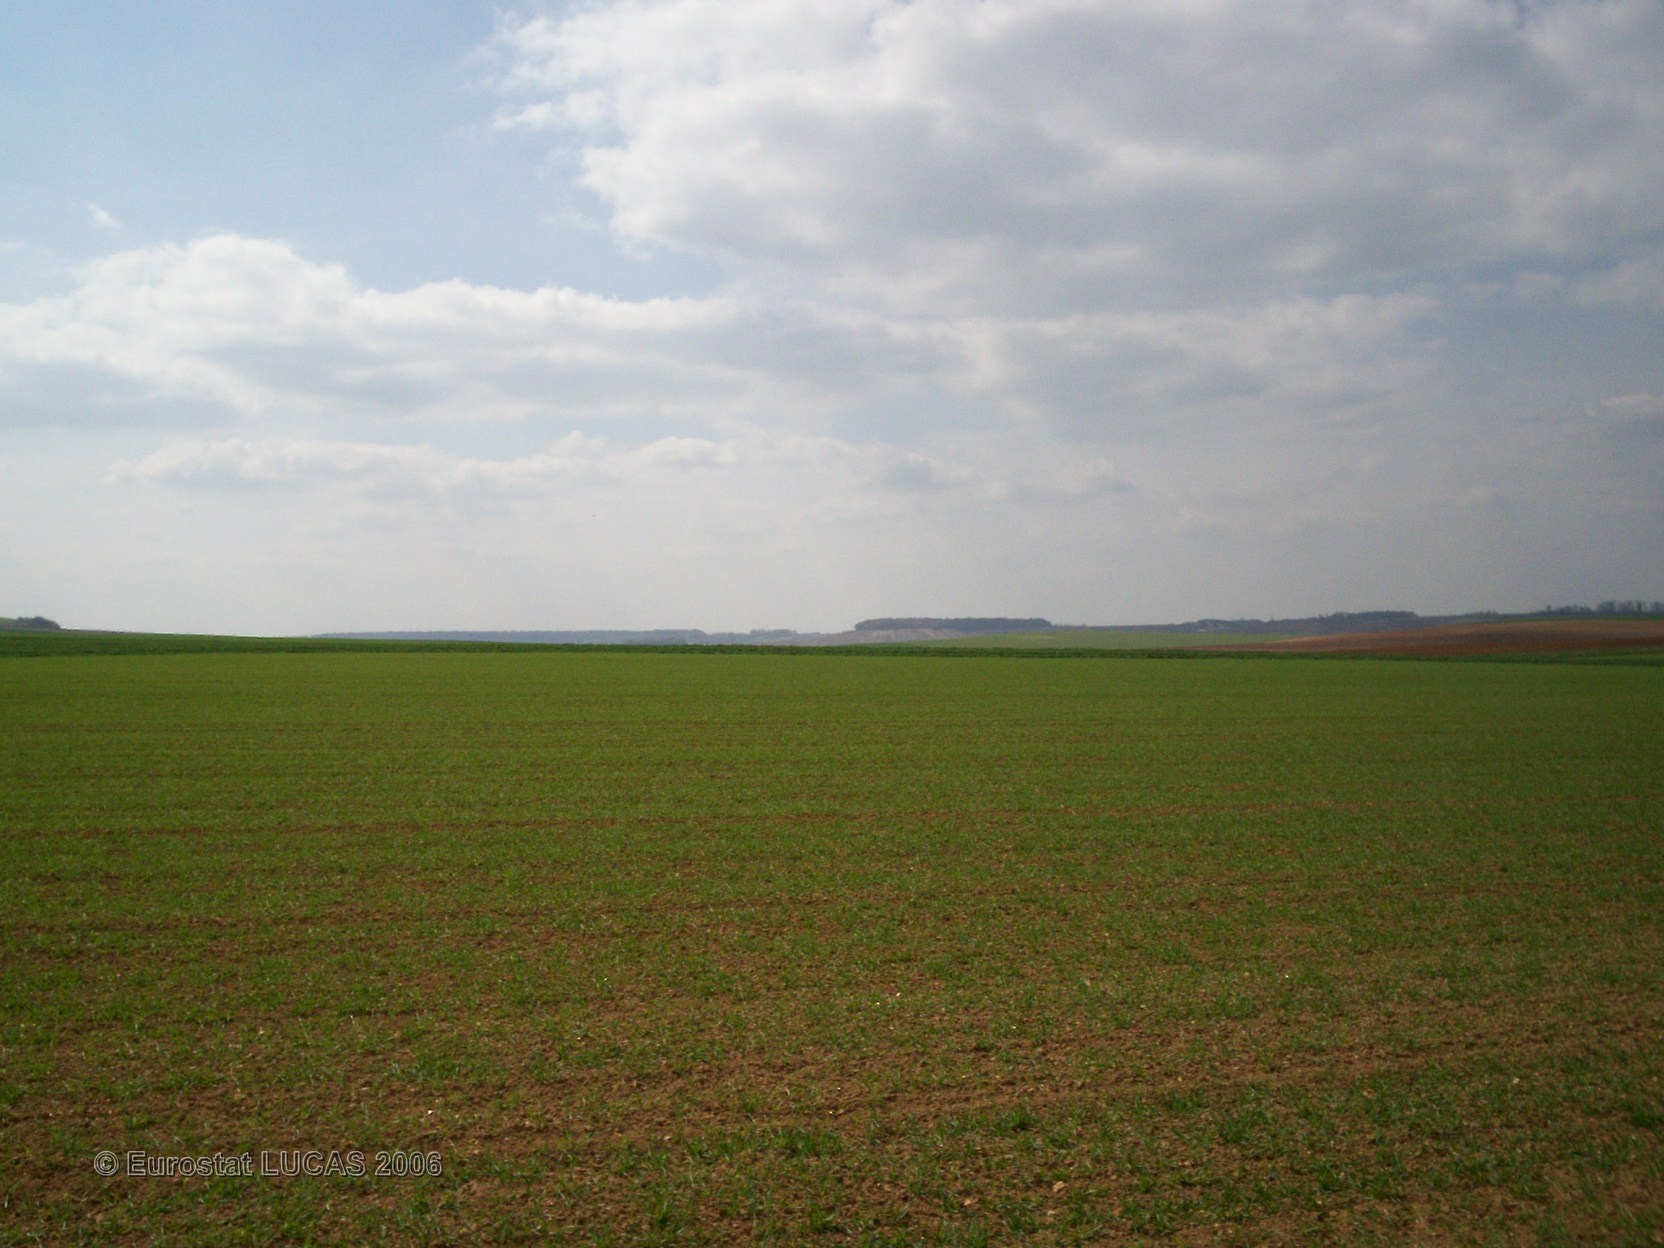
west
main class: Cropland
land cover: Barley
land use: Agriculture (excluding fallow land and kitchen gardens)
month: April
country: FR
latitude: 48.8666
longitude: 3.9013
